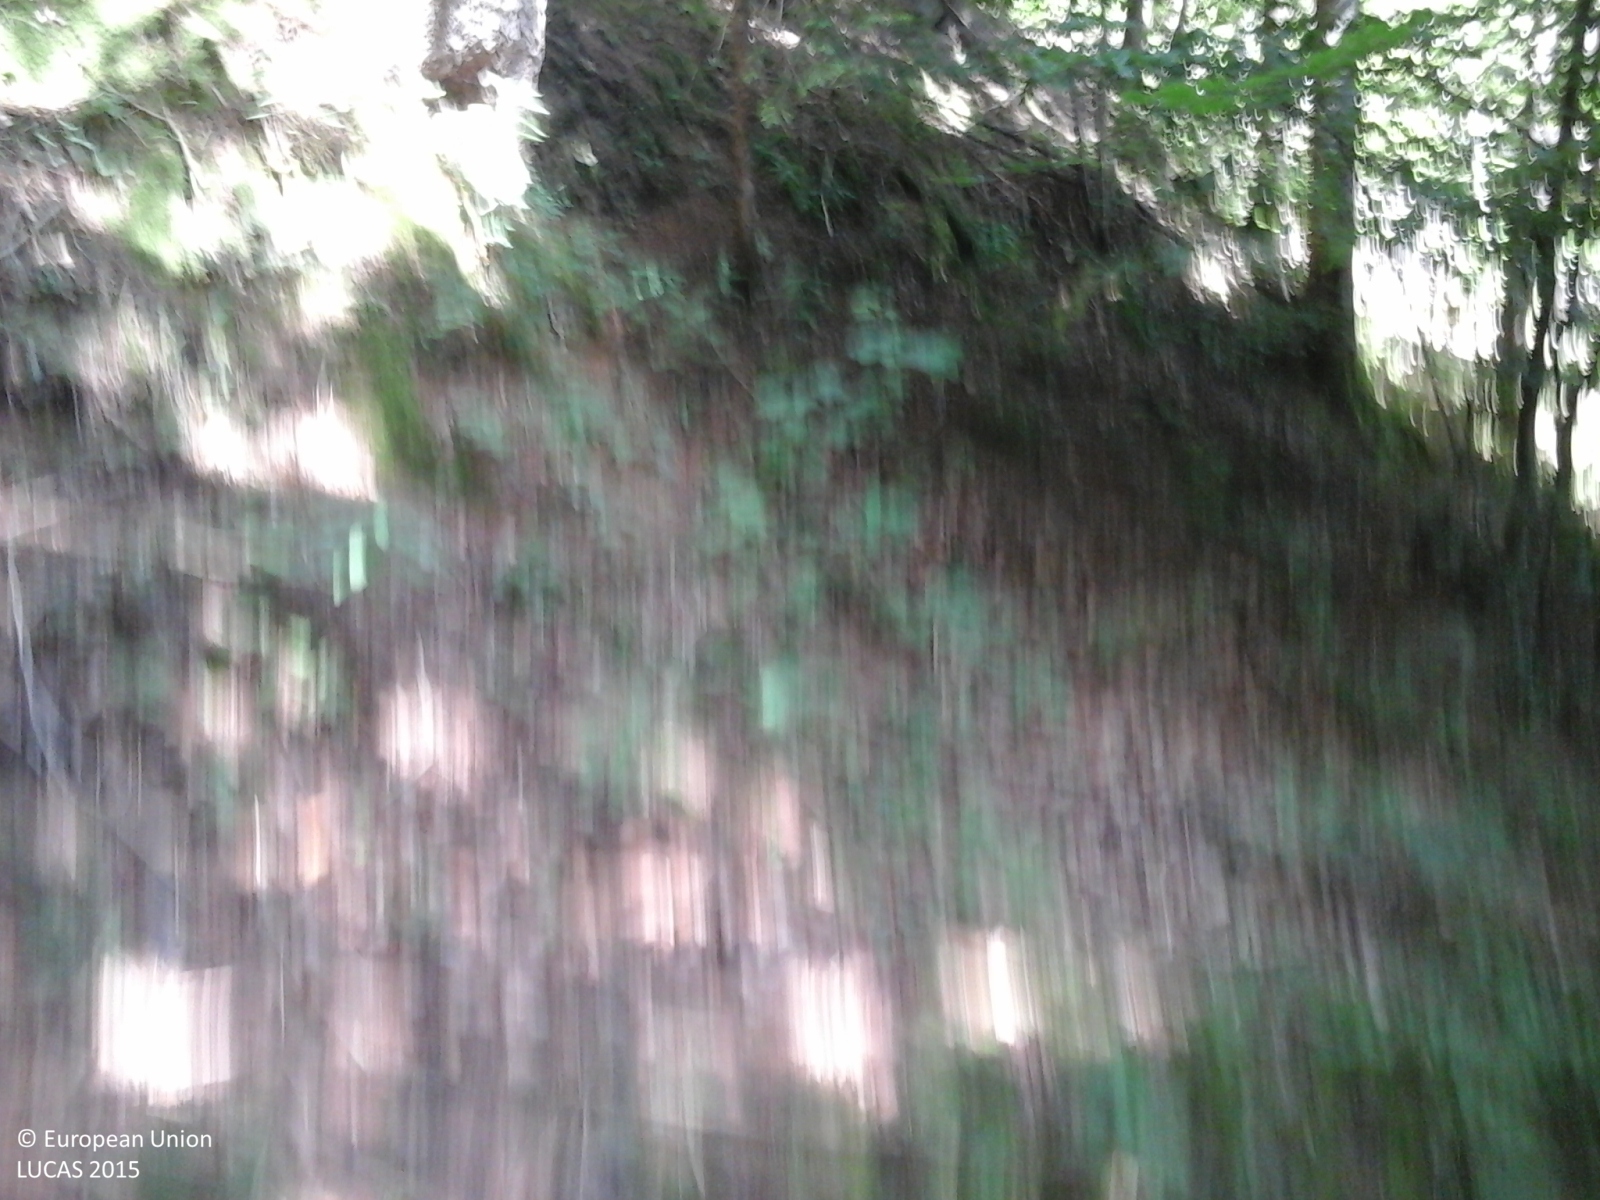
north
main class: Woodland
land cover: Spruce dominated coniferous woodland
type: alpine coniferous forest
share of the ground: > 75 %
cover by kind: coniferous forest trees 75 %, broadleaved forest trees 25 %
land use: Semi-natural and natural areas not in use
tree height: > 5 m
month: July
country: IT
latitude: 46.0089
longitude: 10.1161
